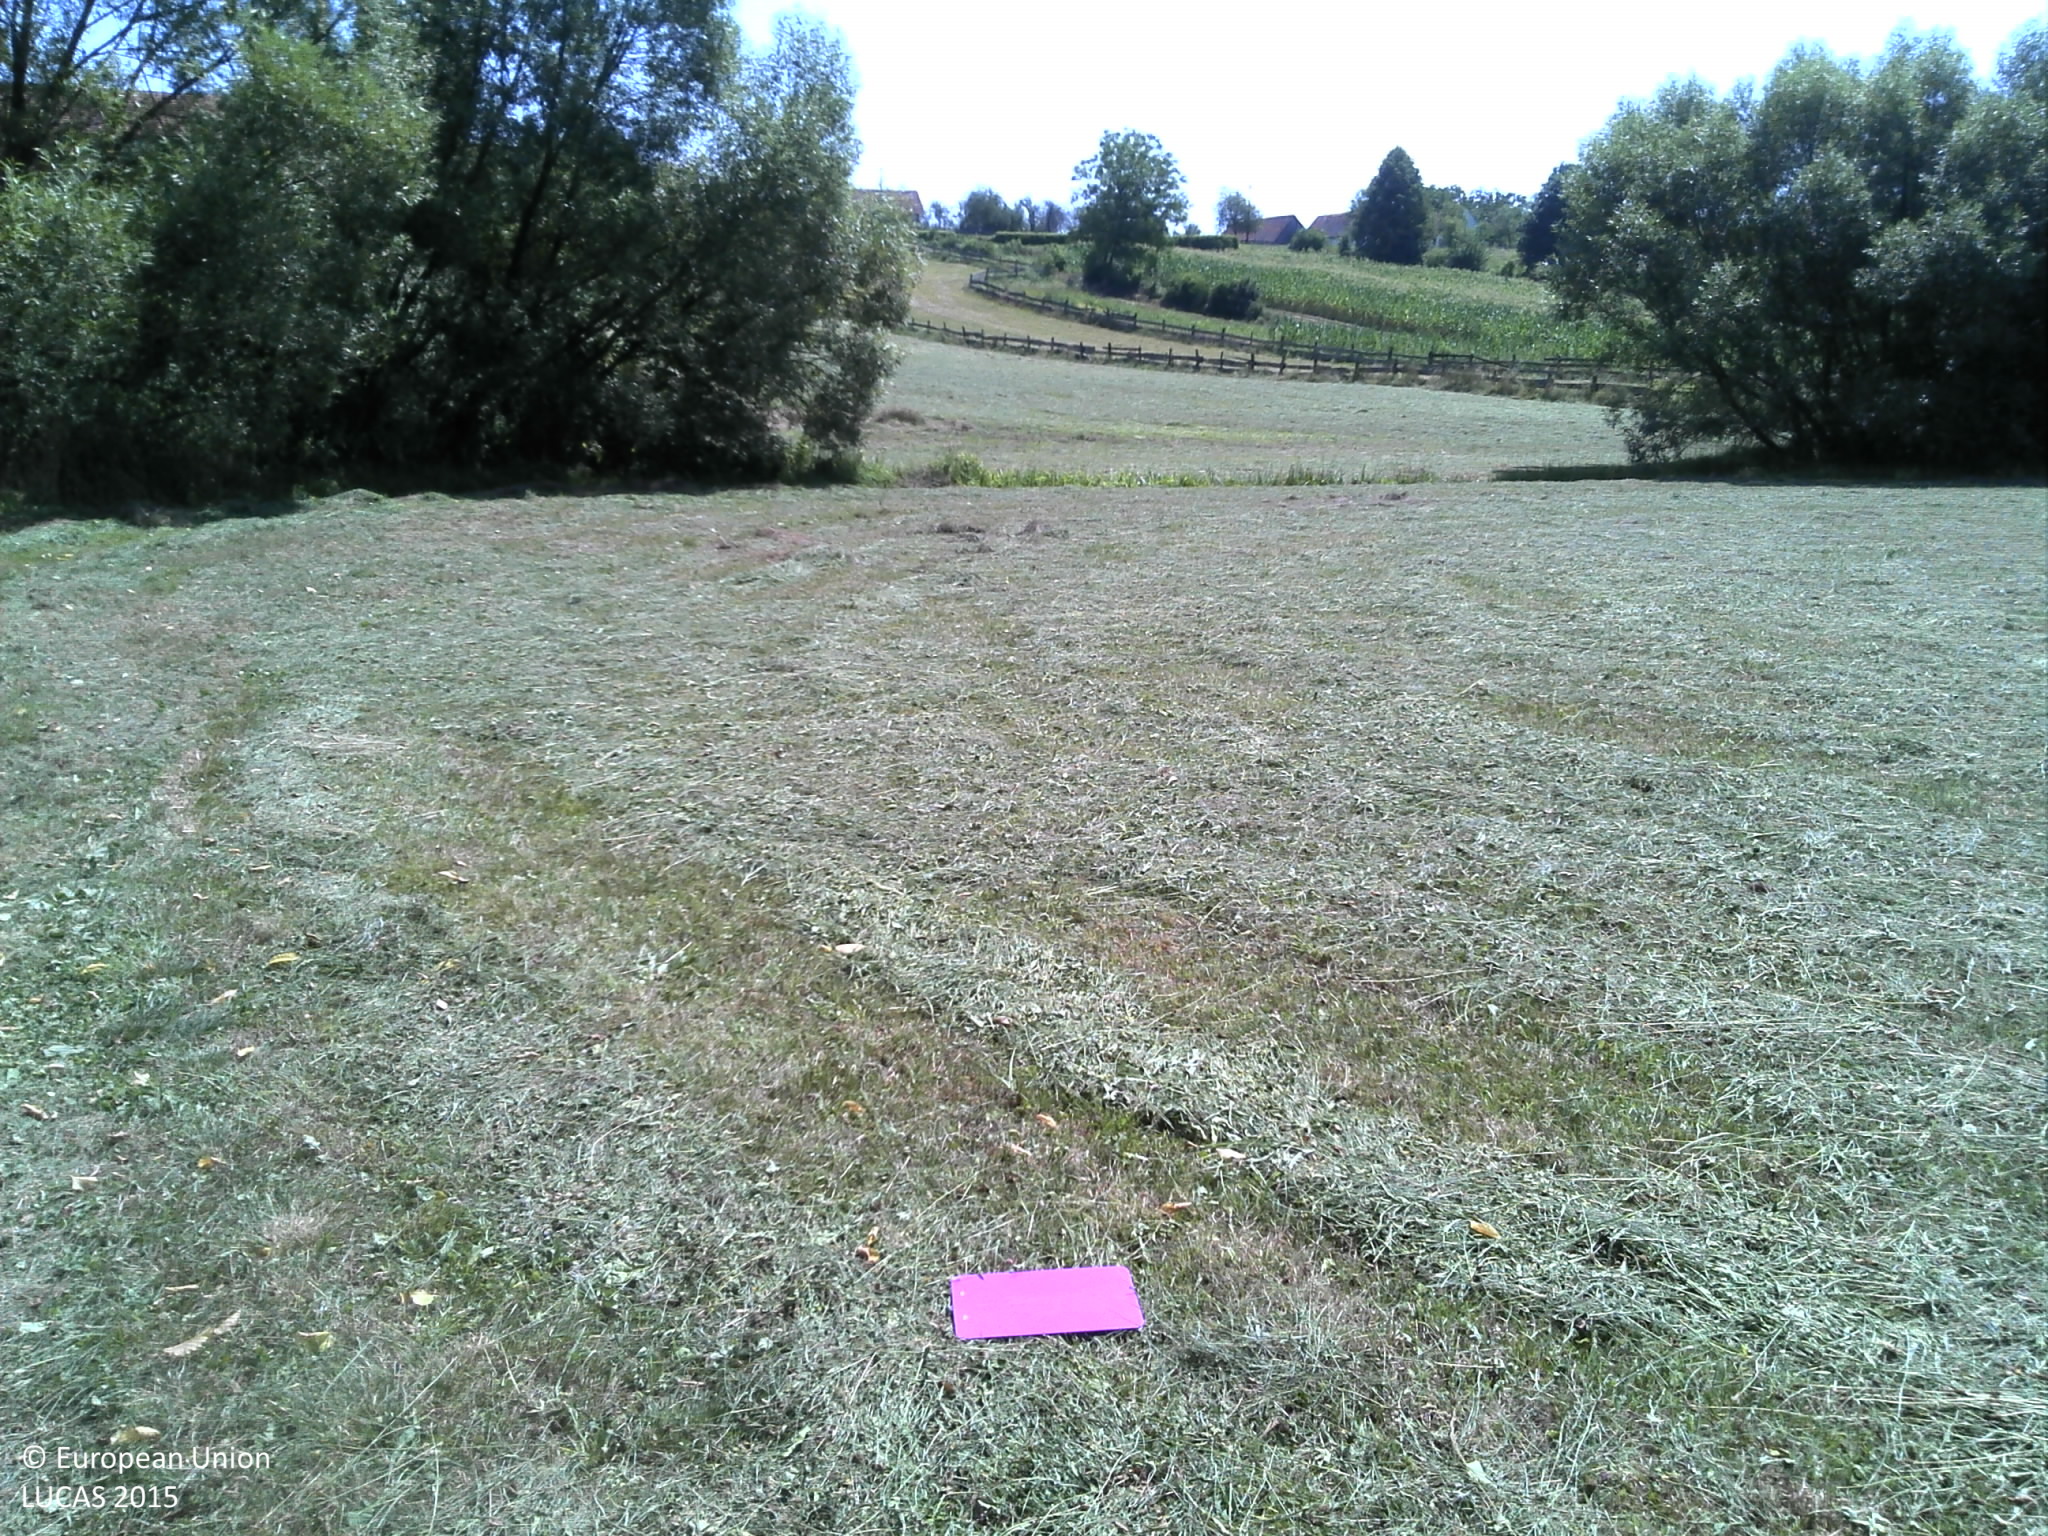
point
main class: Cropland
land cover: Clovers
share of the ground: > 75 %
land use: Agriculture (excluding fallow land and kitchen gardens)
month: July
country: HR
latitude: 45.6996
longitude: 16.8194
